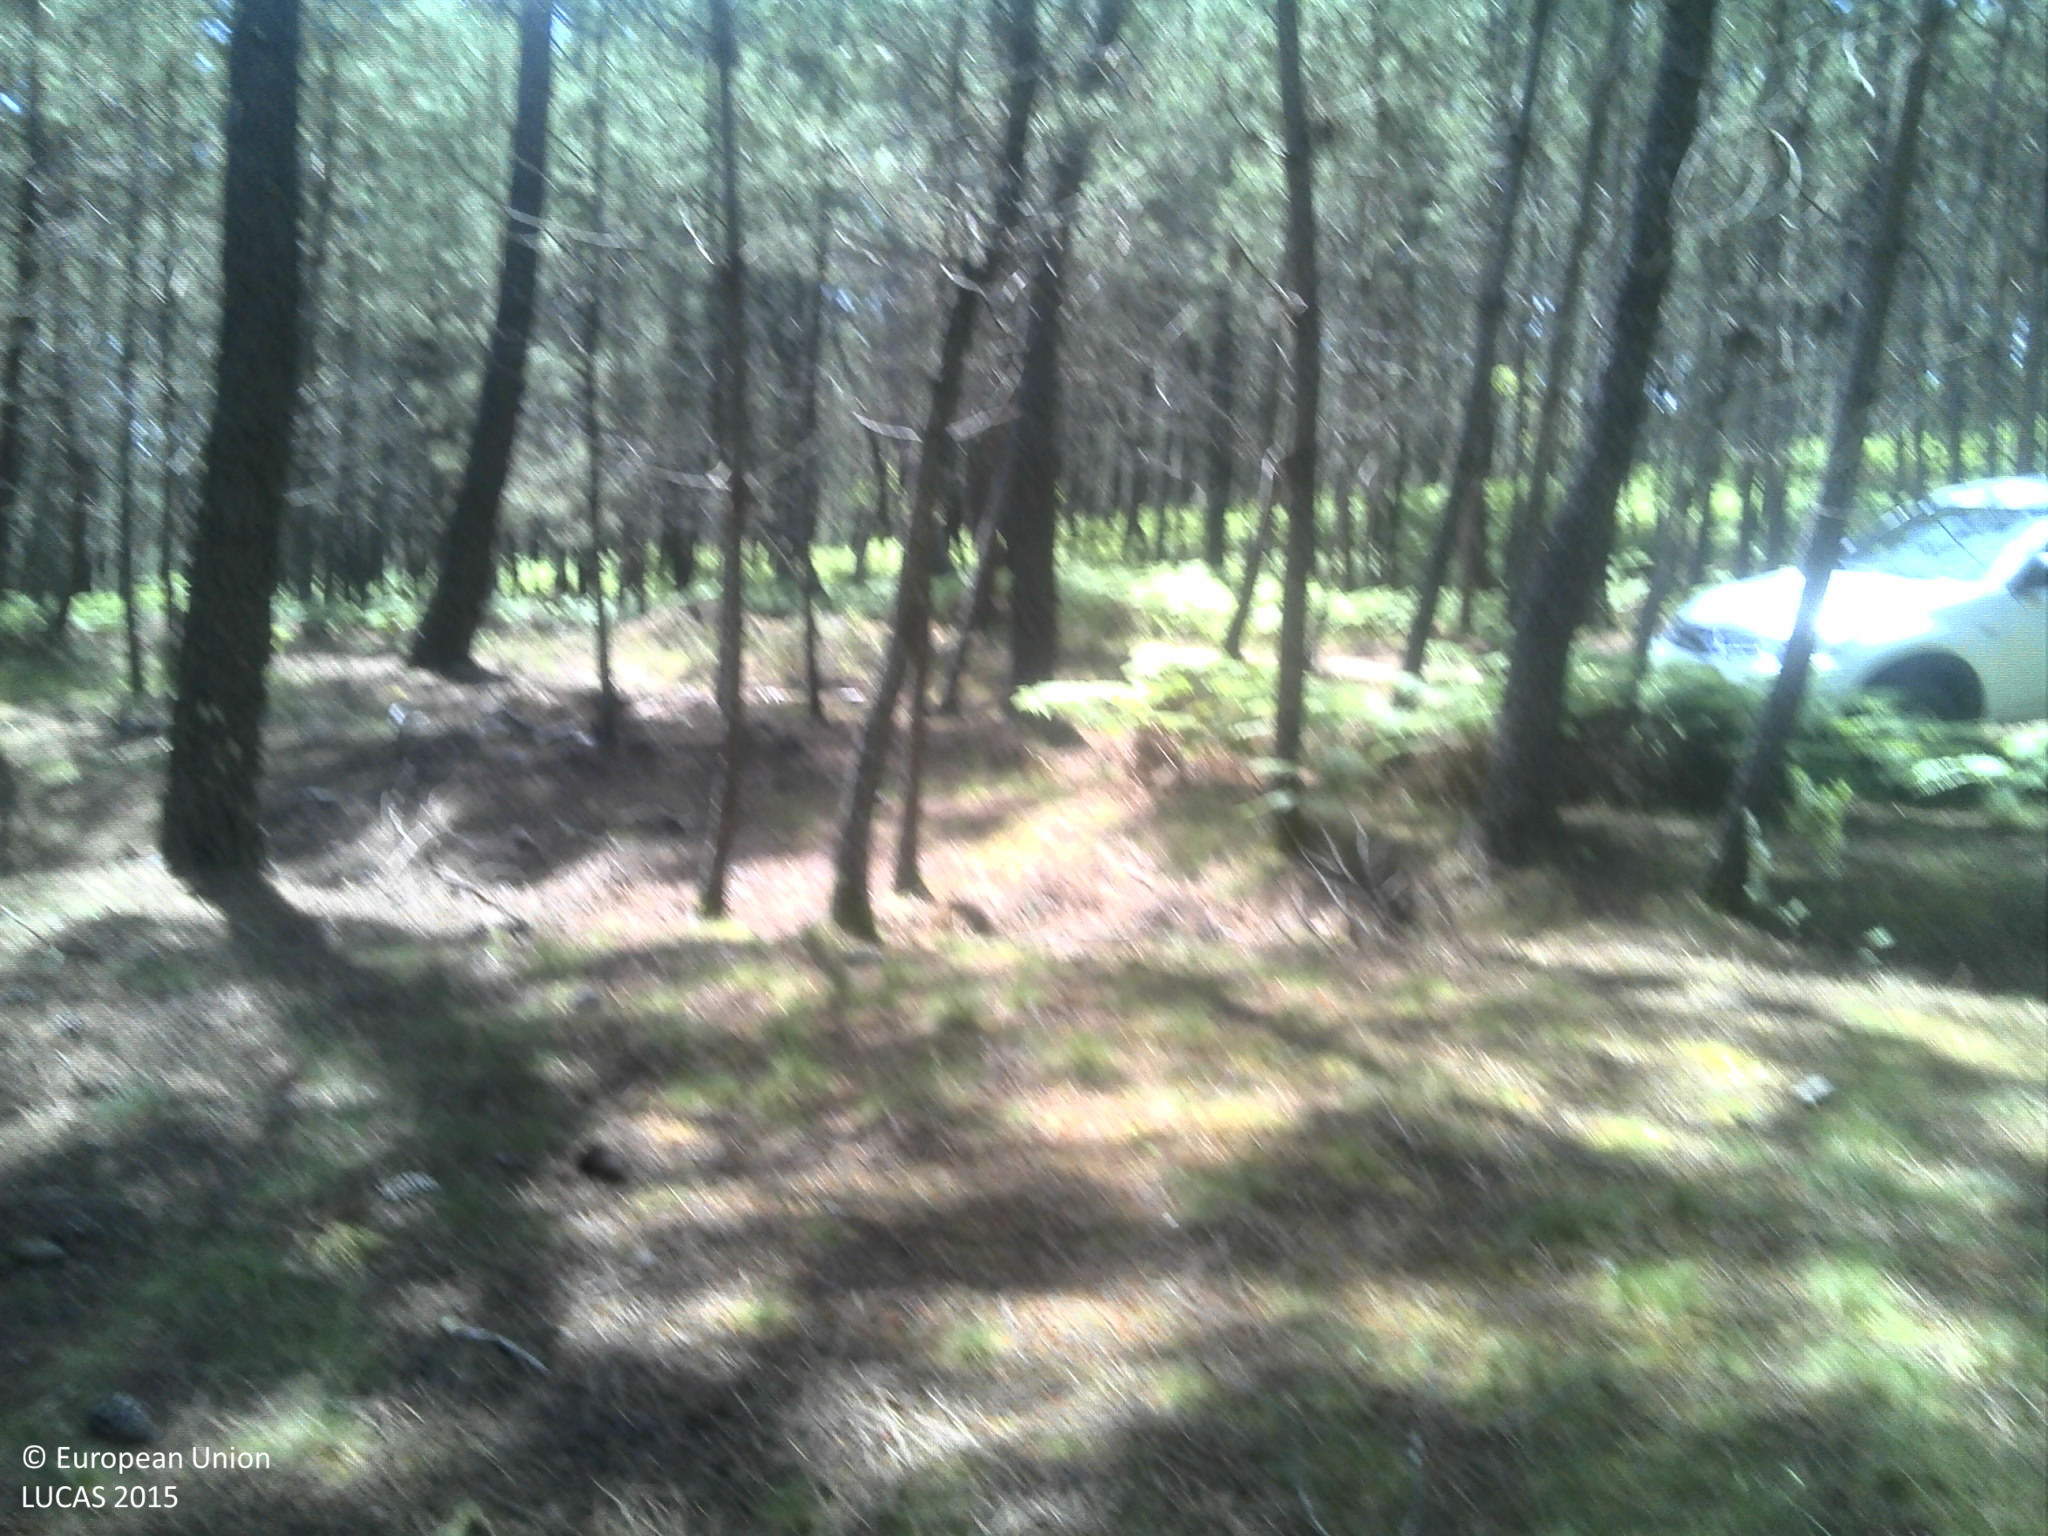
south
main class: Woodland
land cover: Pine dominated coniferous woodland
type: coniferous forest of the mediterranean region
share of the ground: > 75 %
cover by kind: coniferous forest trees 90 %, shrubs 10 %
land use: Forestry
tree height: > 5 m
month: May
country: PT
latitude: 40.6907
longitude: -7.8132
